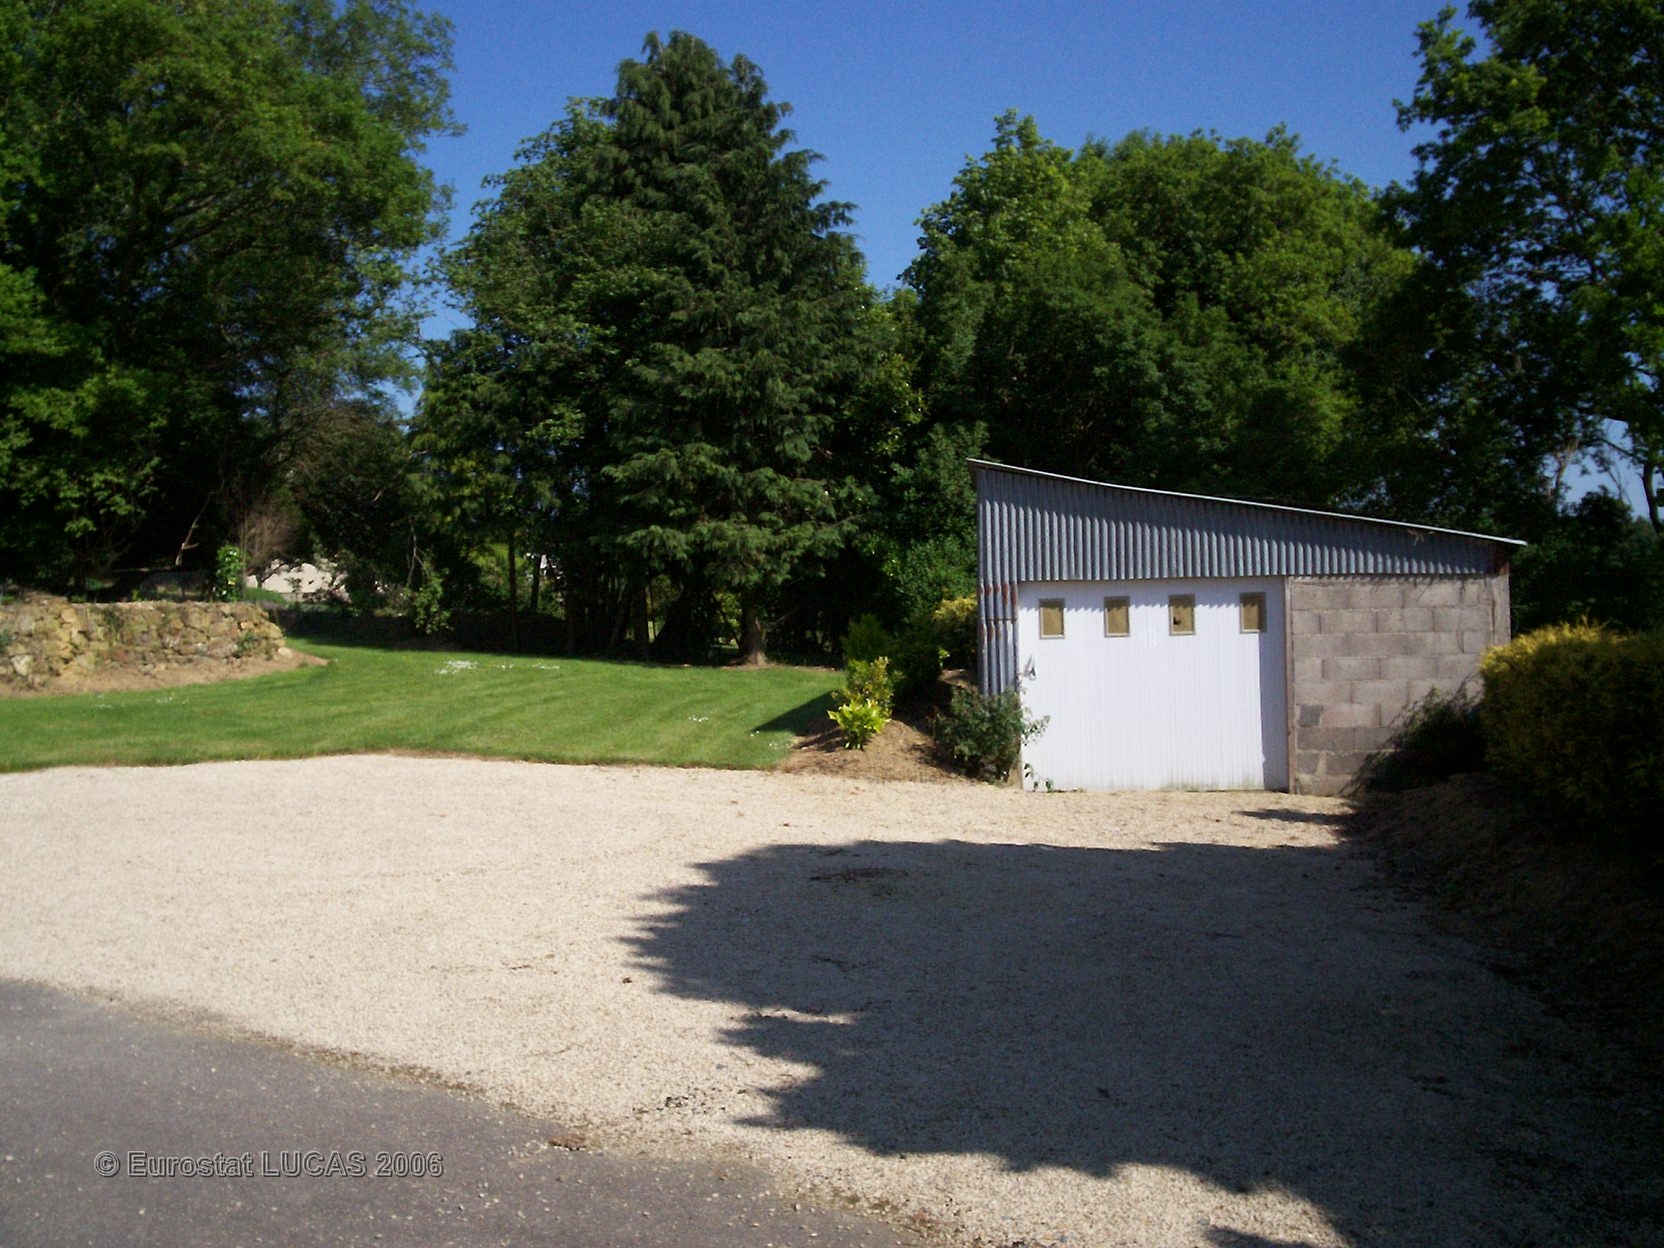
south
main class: Grassland
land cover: Grassland with sparse tree/shrub cover
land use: Residential
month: June
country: FR
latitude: 48.4229
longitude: -3.6900
